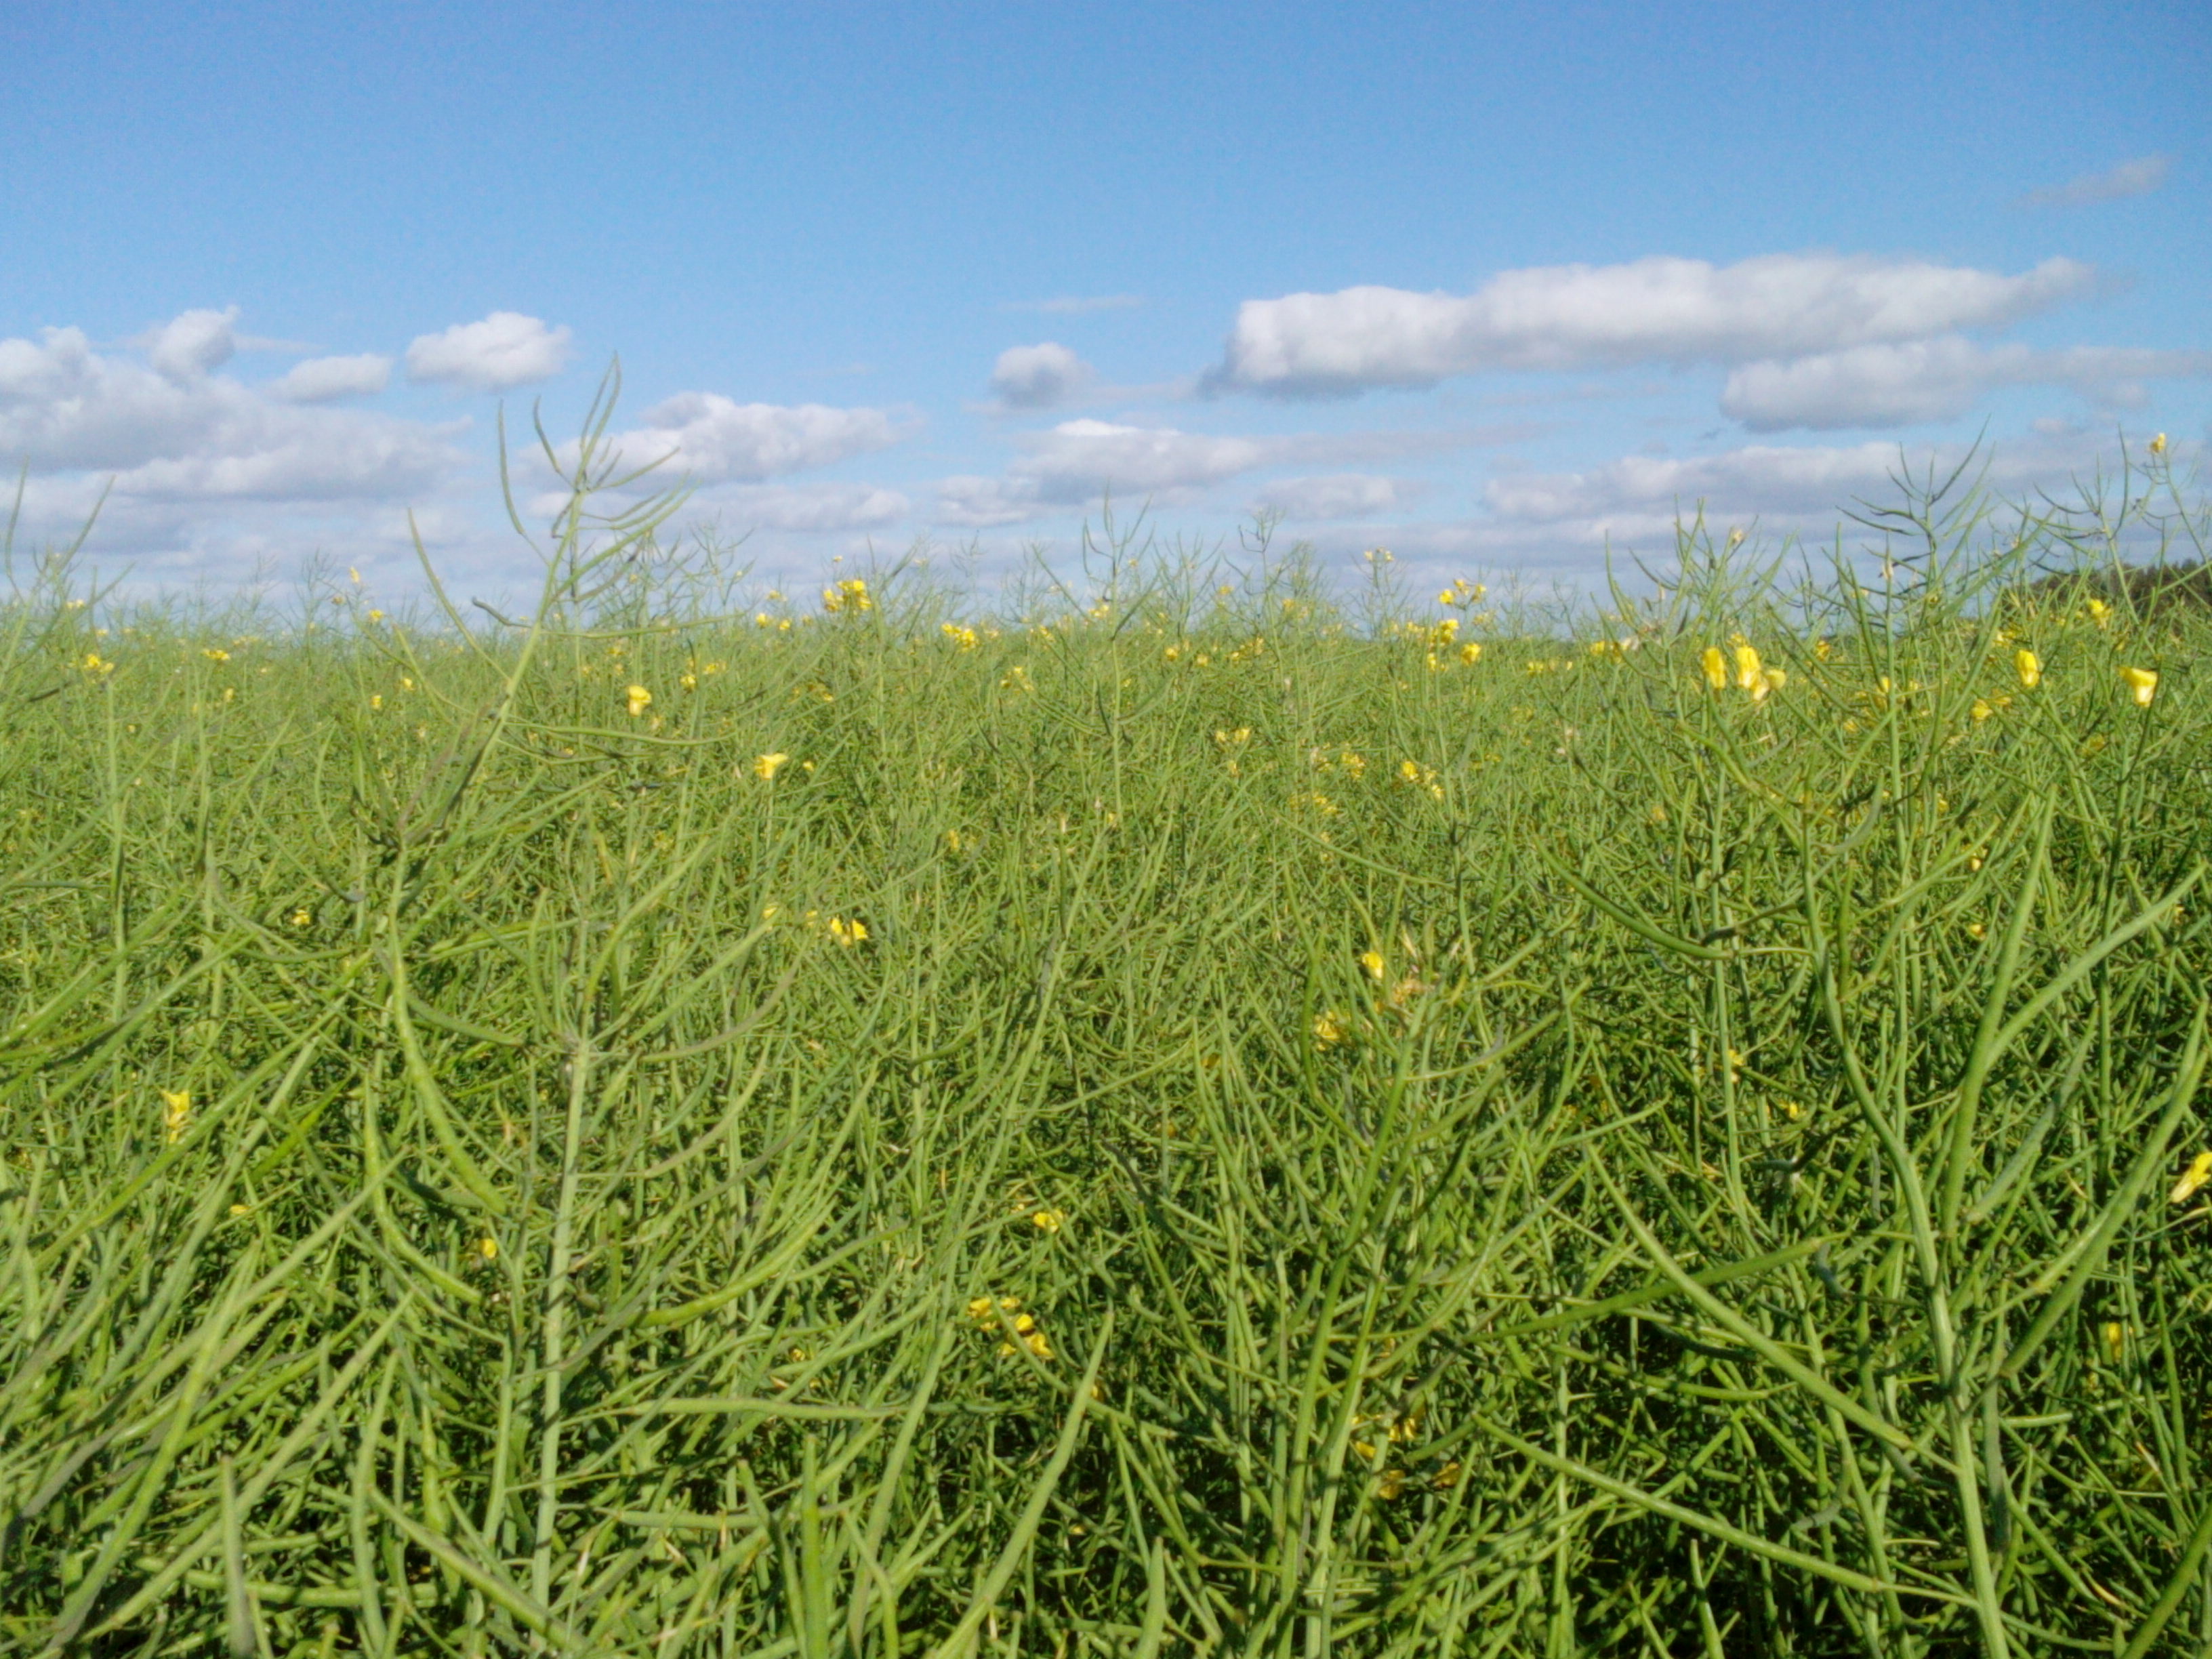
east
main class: Cropland
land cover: Rape and turnip rape
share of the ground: > 75 %
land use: Agriculture (excluding fallow land and kitchen gardens)
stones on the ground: < 10 %
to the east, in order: Rape and turnip rape; Grass margins; Paved roads, cycling and walking lanes; Grass margins; Common wheat; Electric lines; Common wheat
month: June
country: LV
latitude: 56.6940
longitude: 22.2169
